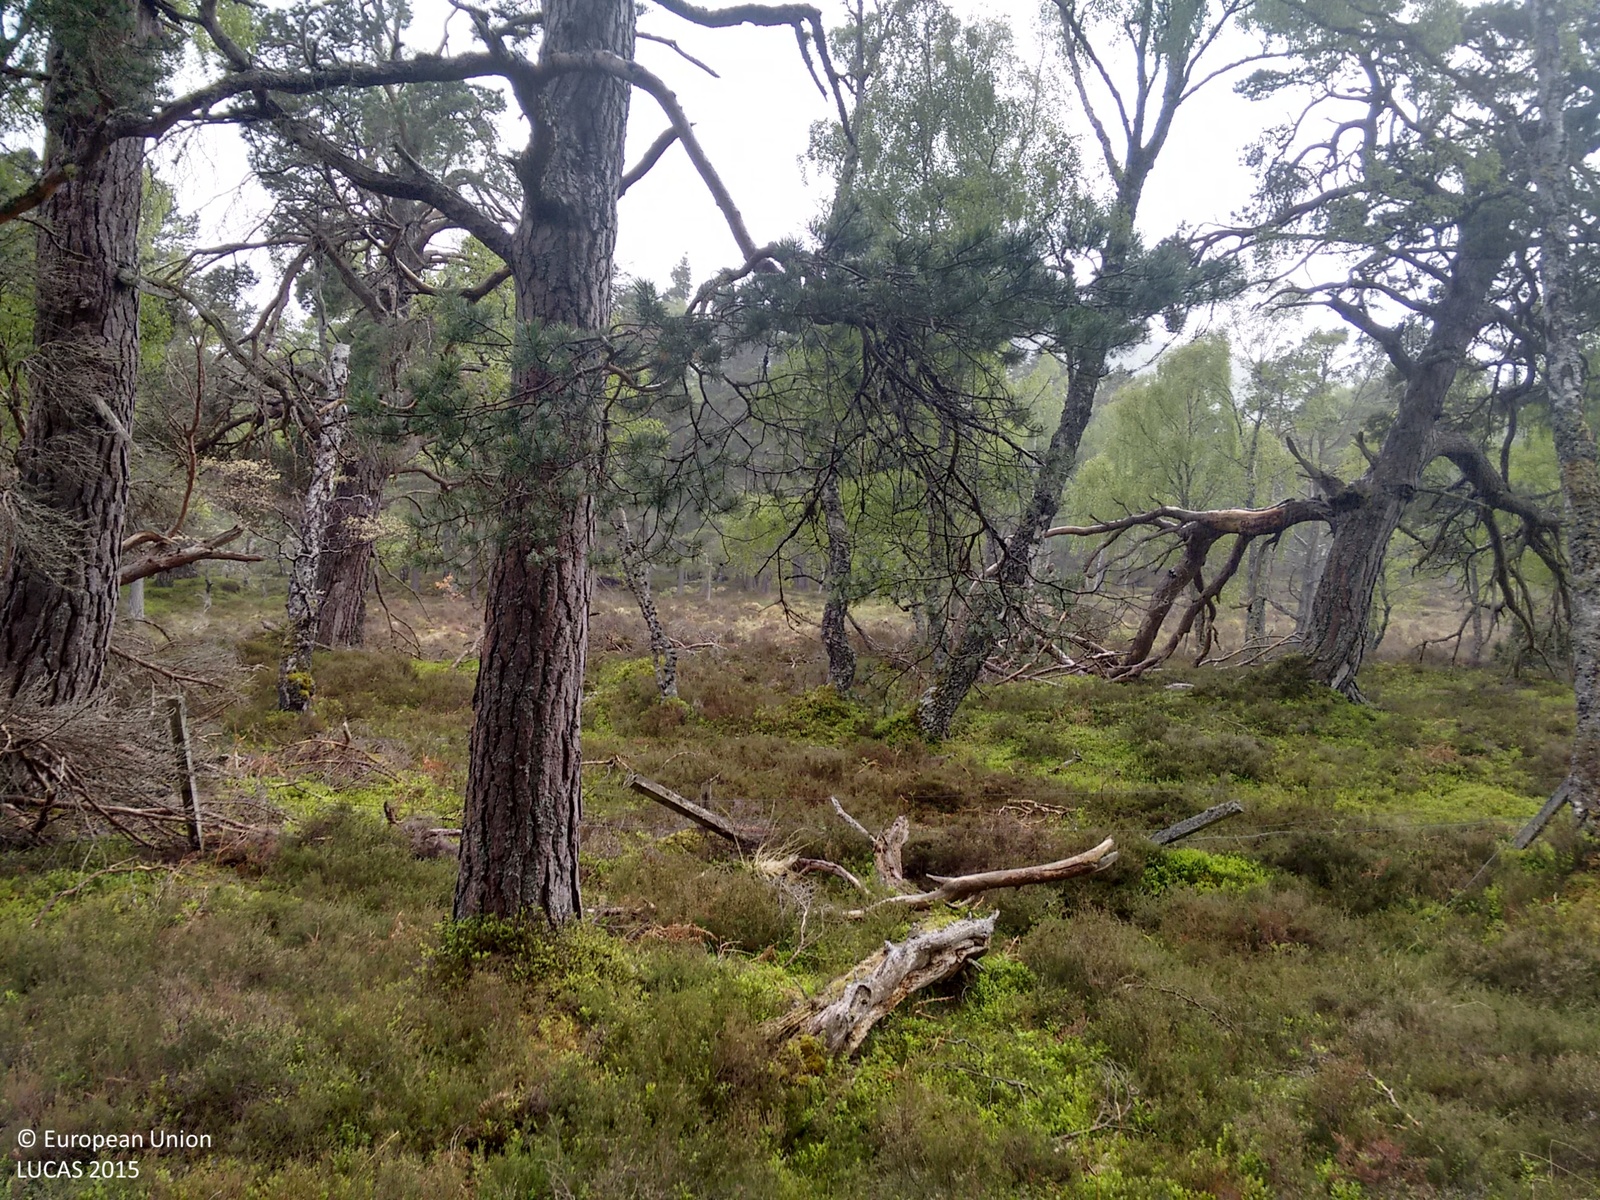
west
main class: Woodland
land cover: Pine dominated mixed woodland
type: hemiboreal forest and nemoral coniferous forest and mixed broadleaved-coniferous forest
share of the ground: > 75 %
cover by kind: coniferous forest trees 60 %, broadleaved forest trees 25 %, shrubs 15 %
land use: Forestry
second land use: Amenities, museums, leisure
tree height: > 5 m
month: June
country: GB
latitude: 57.1537
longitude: -3.8155
